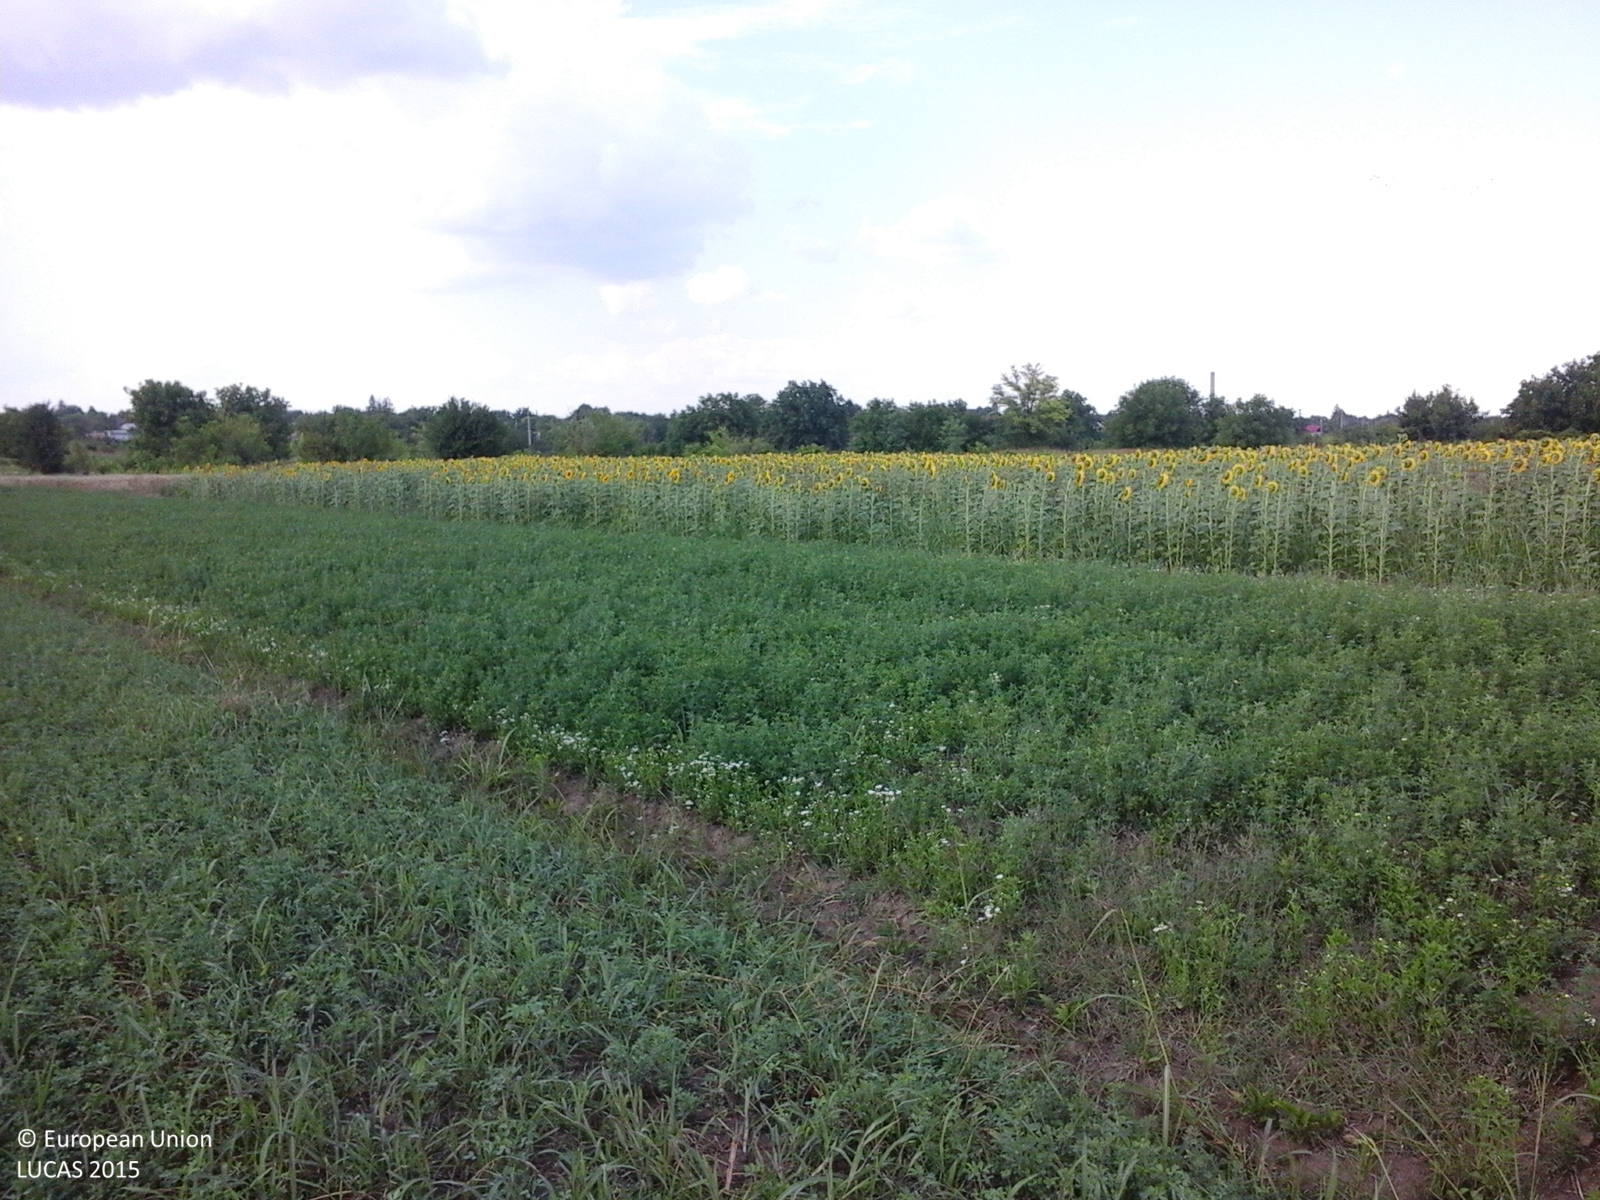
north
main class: Cropland
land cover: Lucerne
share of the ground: > 75 %
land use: Agriculture (excluding fallow land and kitchen gardens)
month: July
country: RO
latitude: 43.8487
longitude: 25.9047
